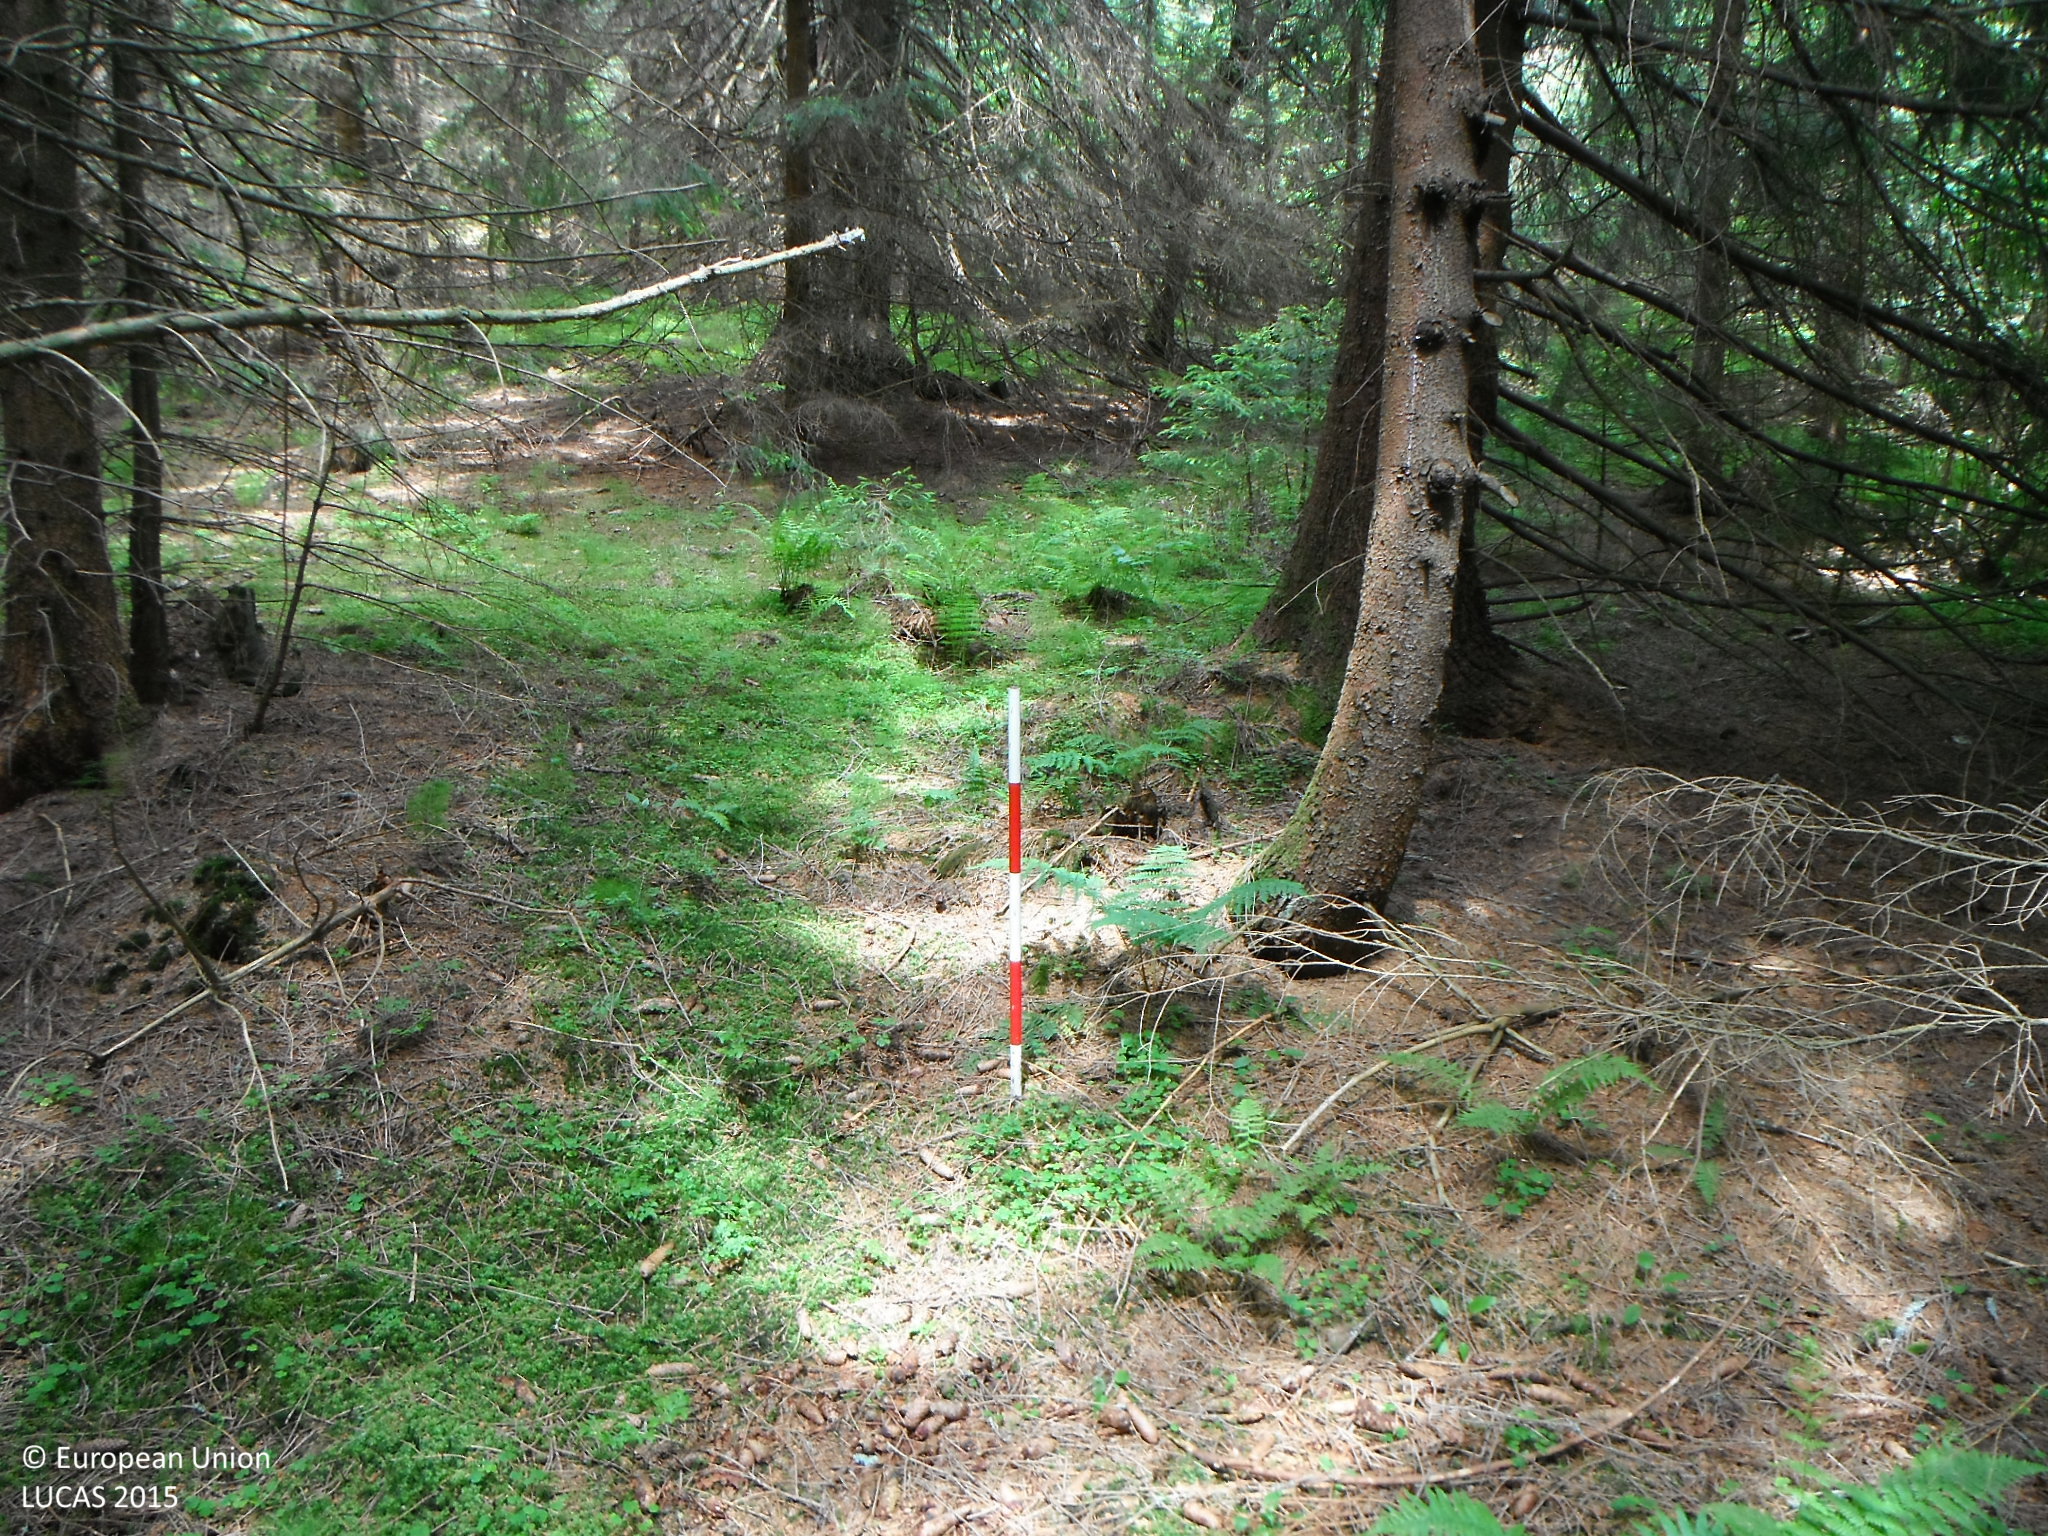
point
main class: Woodland
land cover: Spruce dominated coniferous woodland
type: alpine coniferous forest
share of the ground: > 75 %
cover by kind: coniferous forest trees 100 %
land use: Forestry
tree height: > 5 m
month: June
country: SK
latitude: 49.1908
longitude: 19.4801
